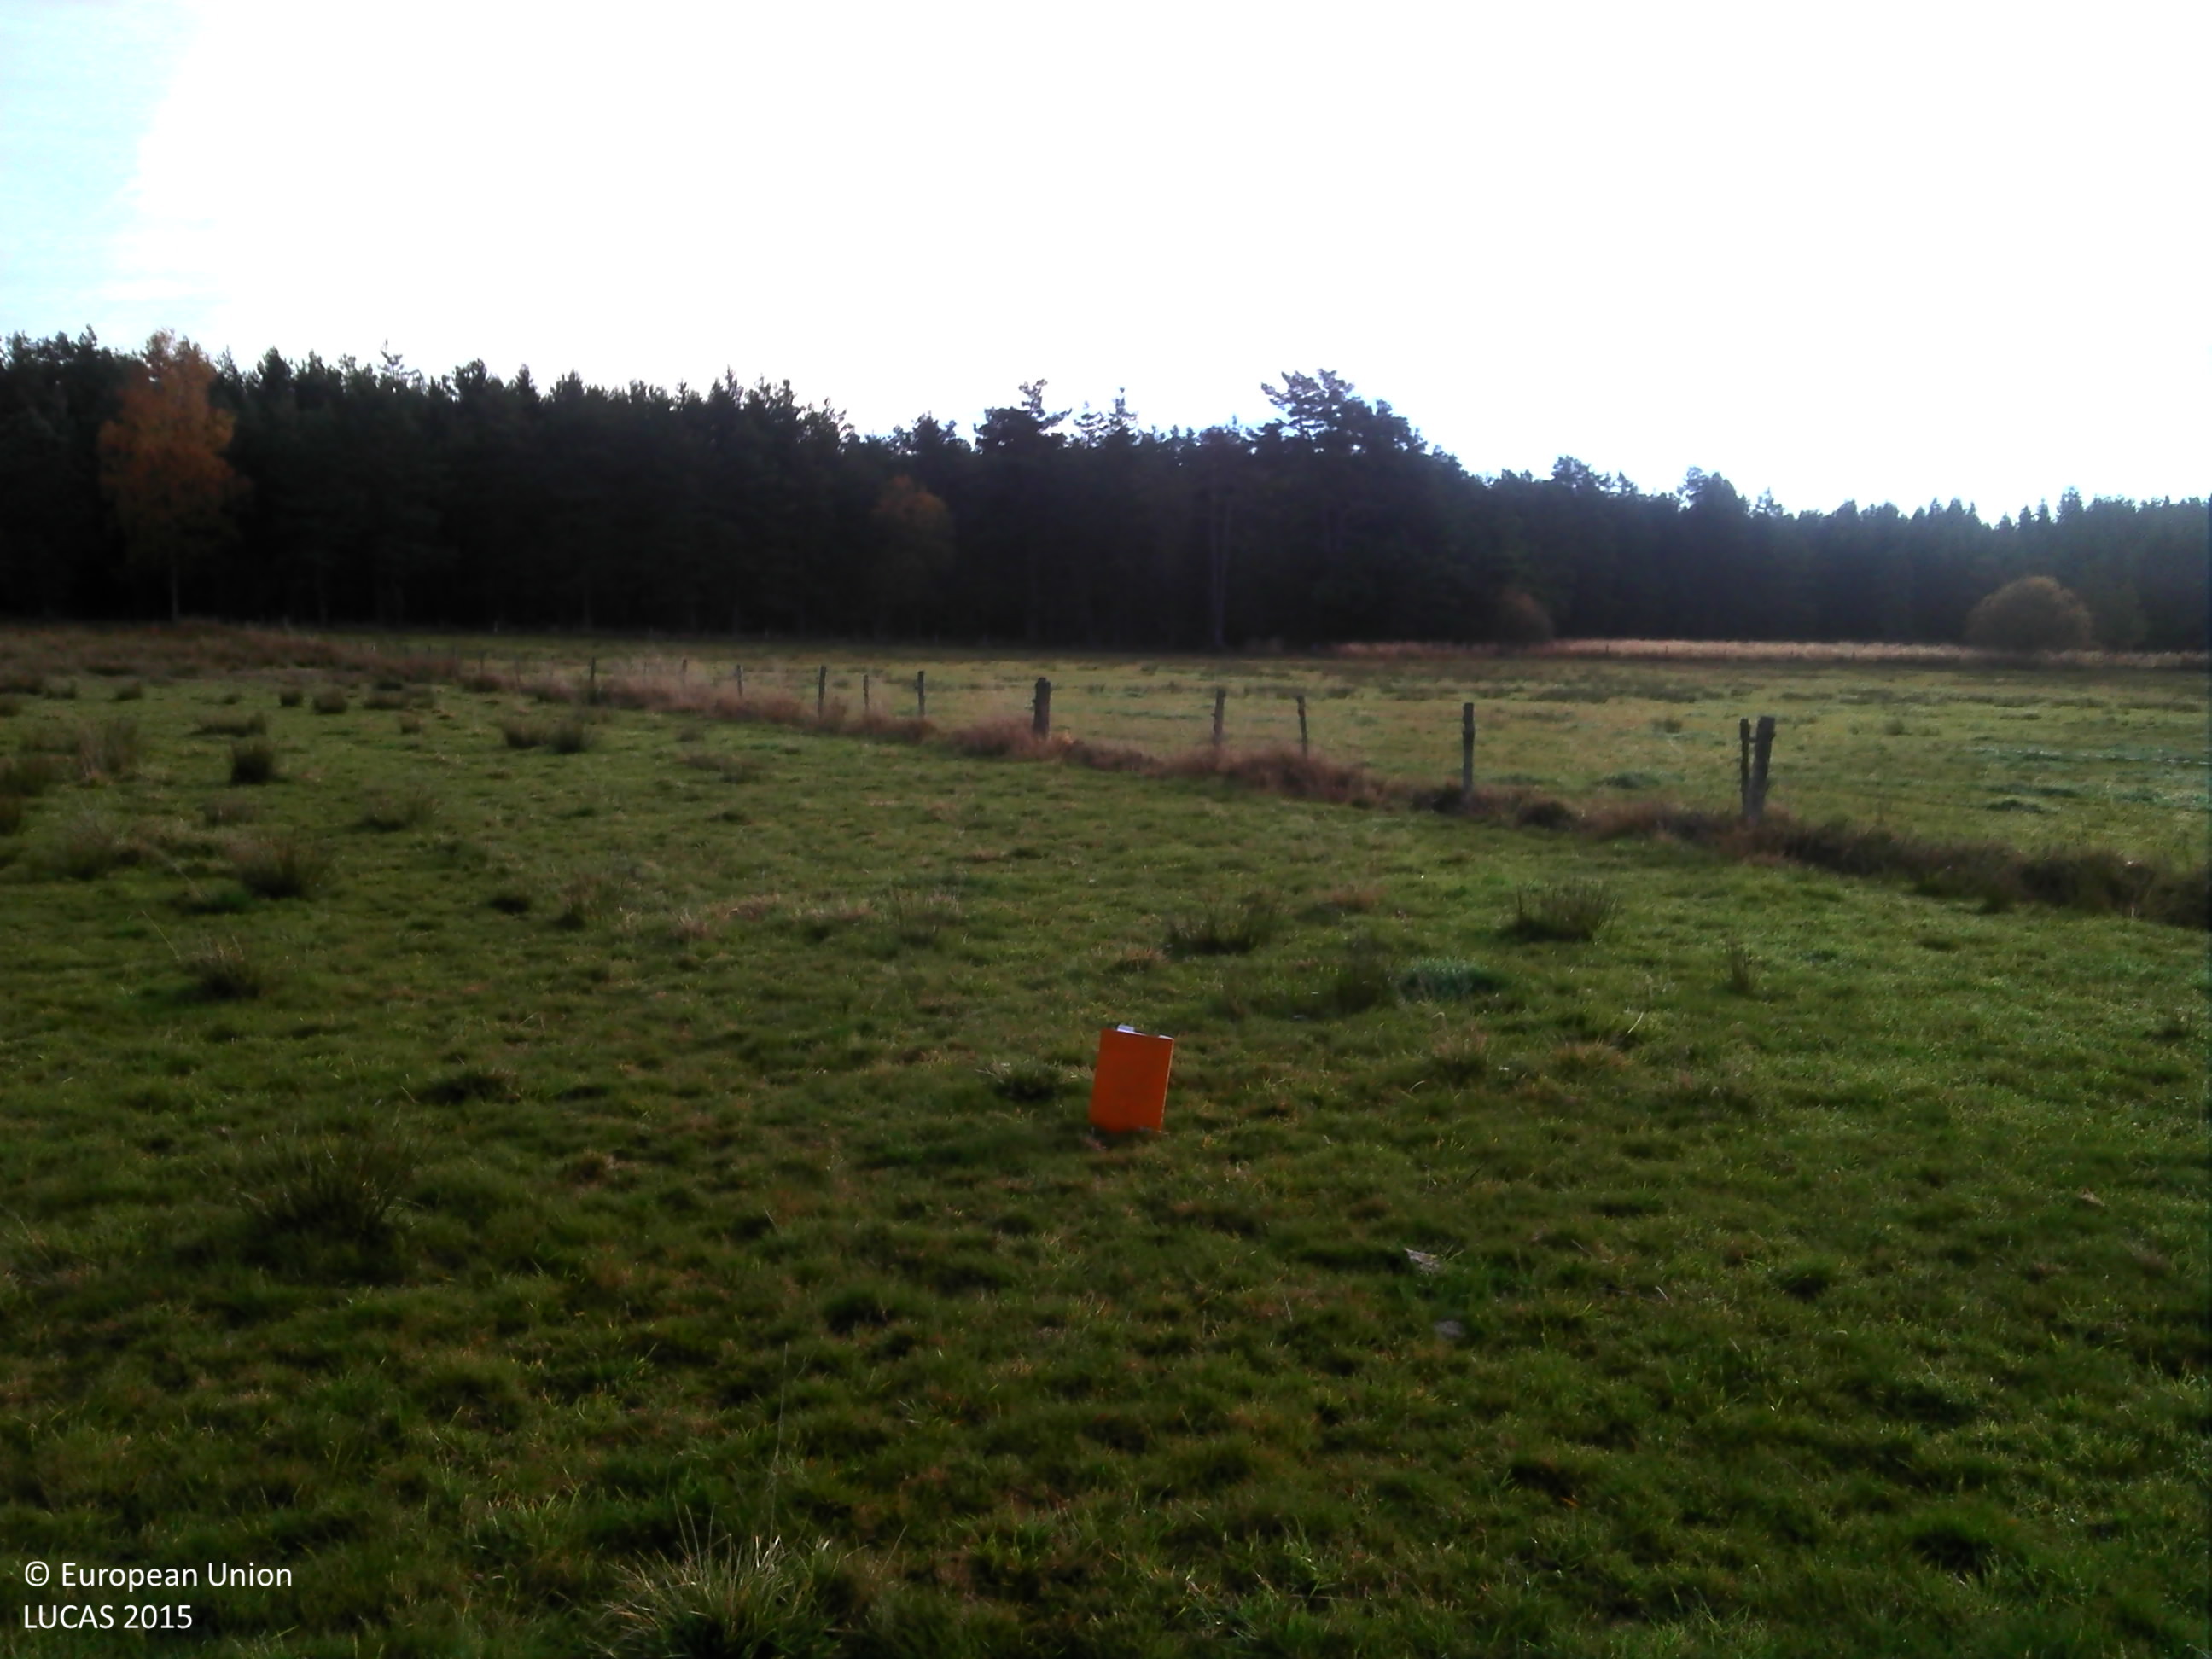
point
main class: Grassland
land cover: Grassland without tree/shrub cover
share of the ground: > 75 %
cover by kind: herbaceous plants 100 %
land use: Agriculture (excluding fallow land and kitchen gardens)
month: November
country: FR
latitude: 45.3216
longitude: 3.7902
